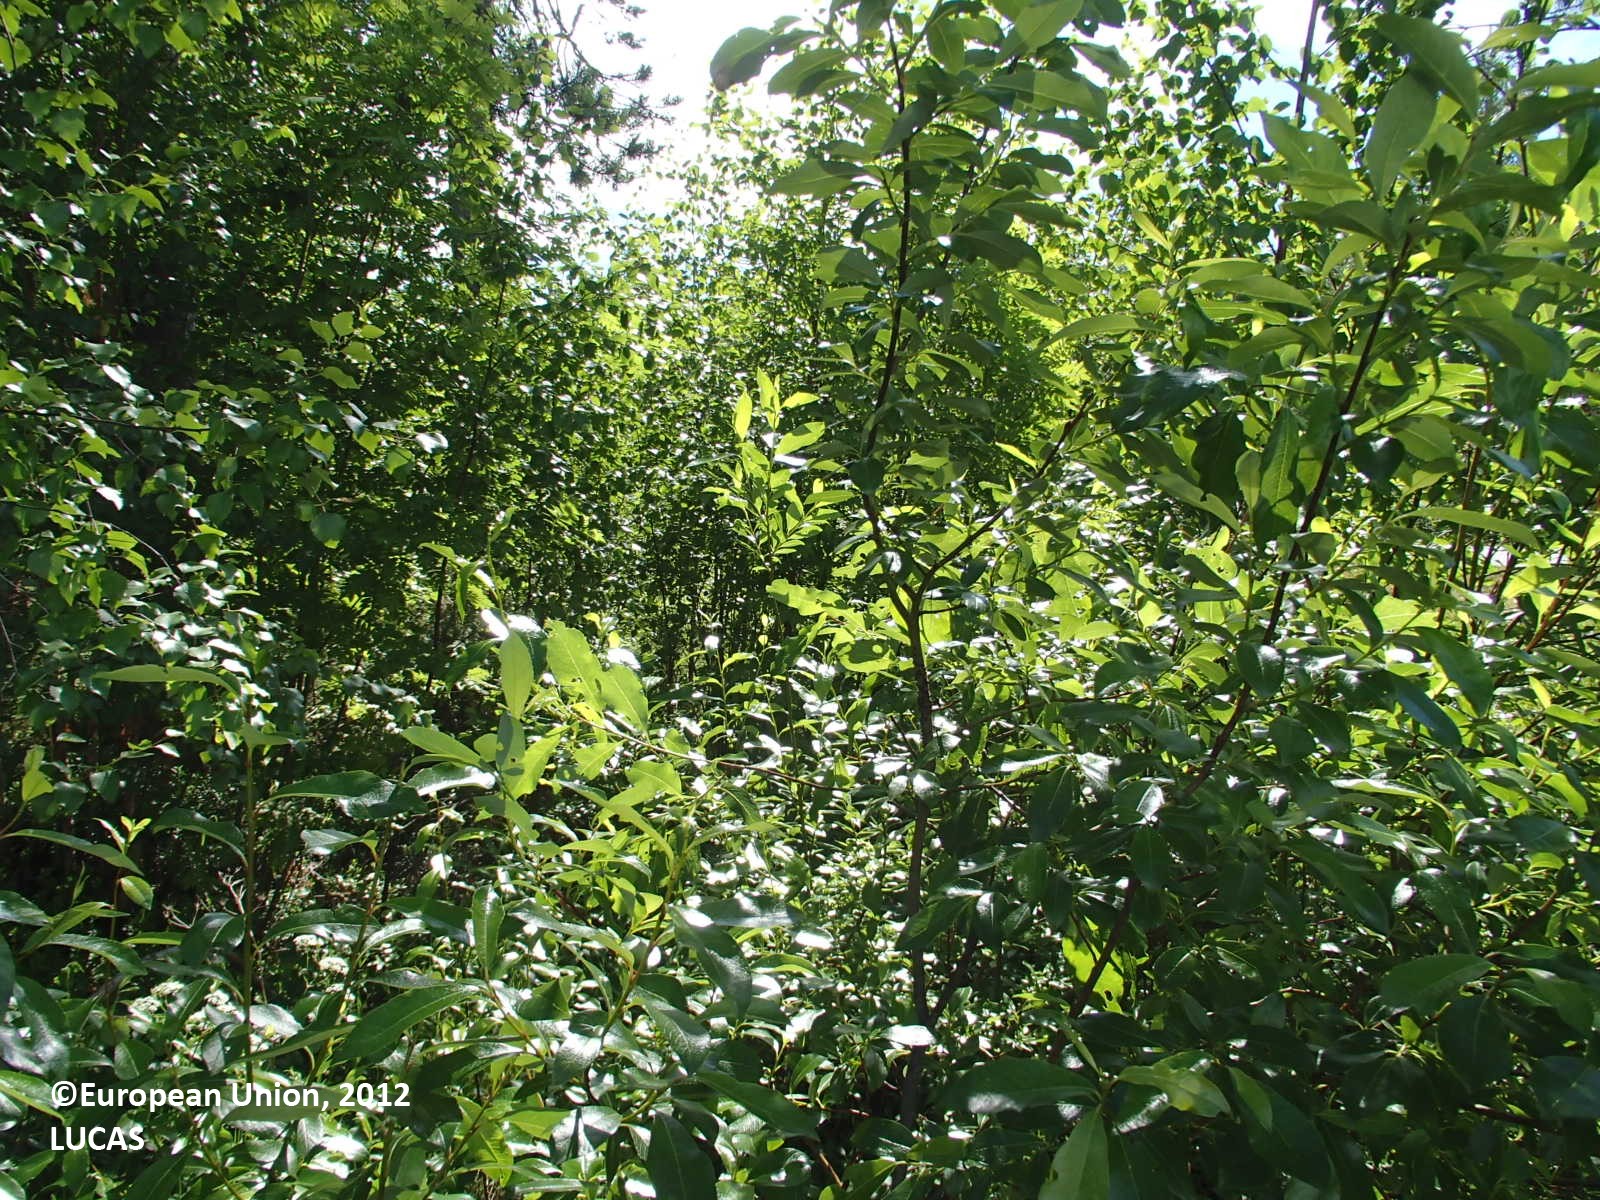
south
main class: Woodland
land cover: Pine dominated mixed woodland
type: boreal forest
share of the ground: > 75 %
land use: Forestry
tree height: > 5 m
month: July
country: FI
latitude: 64.2168
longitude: 26.9657
